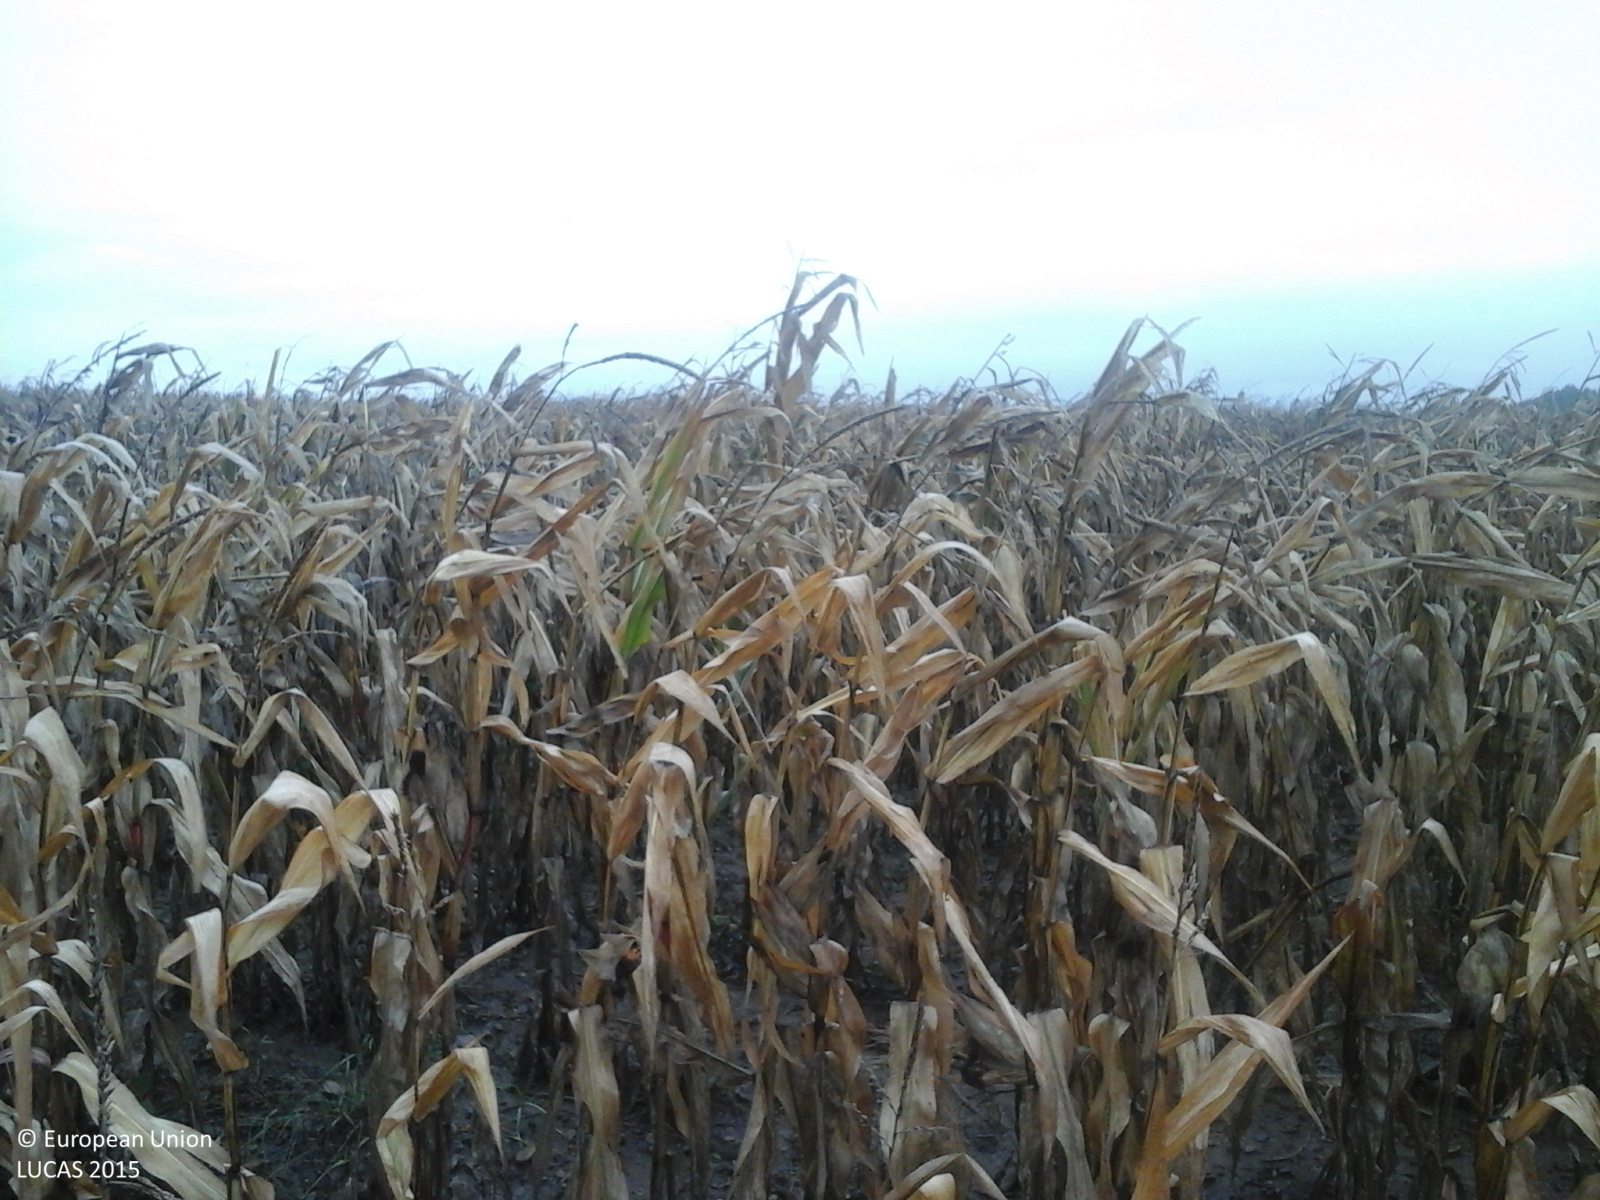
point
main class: Cropland
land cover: Maize
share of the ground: > 75 %
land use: Agriculture (excluding fallow land and kitchen gardens)
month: October
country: RO
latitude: 45.7846
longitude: 24.7107
